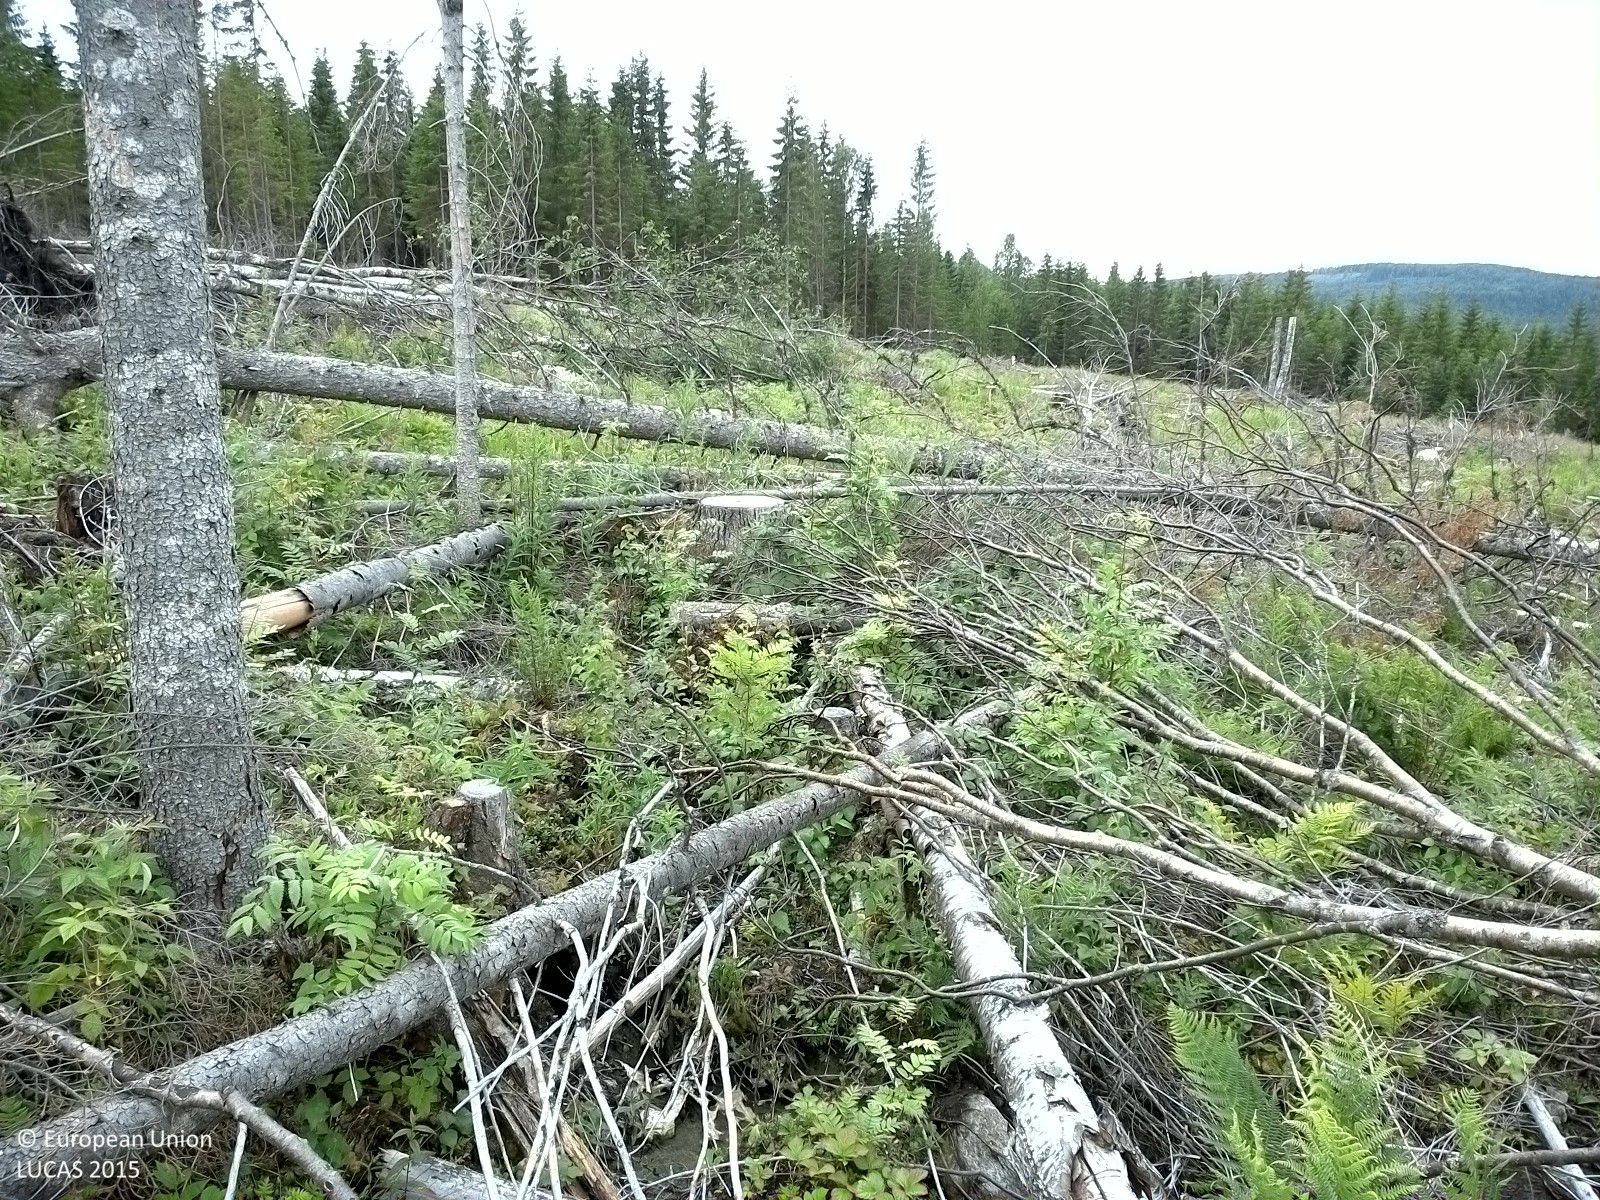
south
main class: Woodland
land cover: Broadleaved woodland
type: boreal forest
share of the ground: 10 - 25 %
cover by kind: shrubs 30 %, herbaceous plants 30 %, broadleaved forest trees 15 %
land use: Forestry
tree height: < 5 m
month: July
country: SE
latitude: 62.0887
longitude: 16.9712
